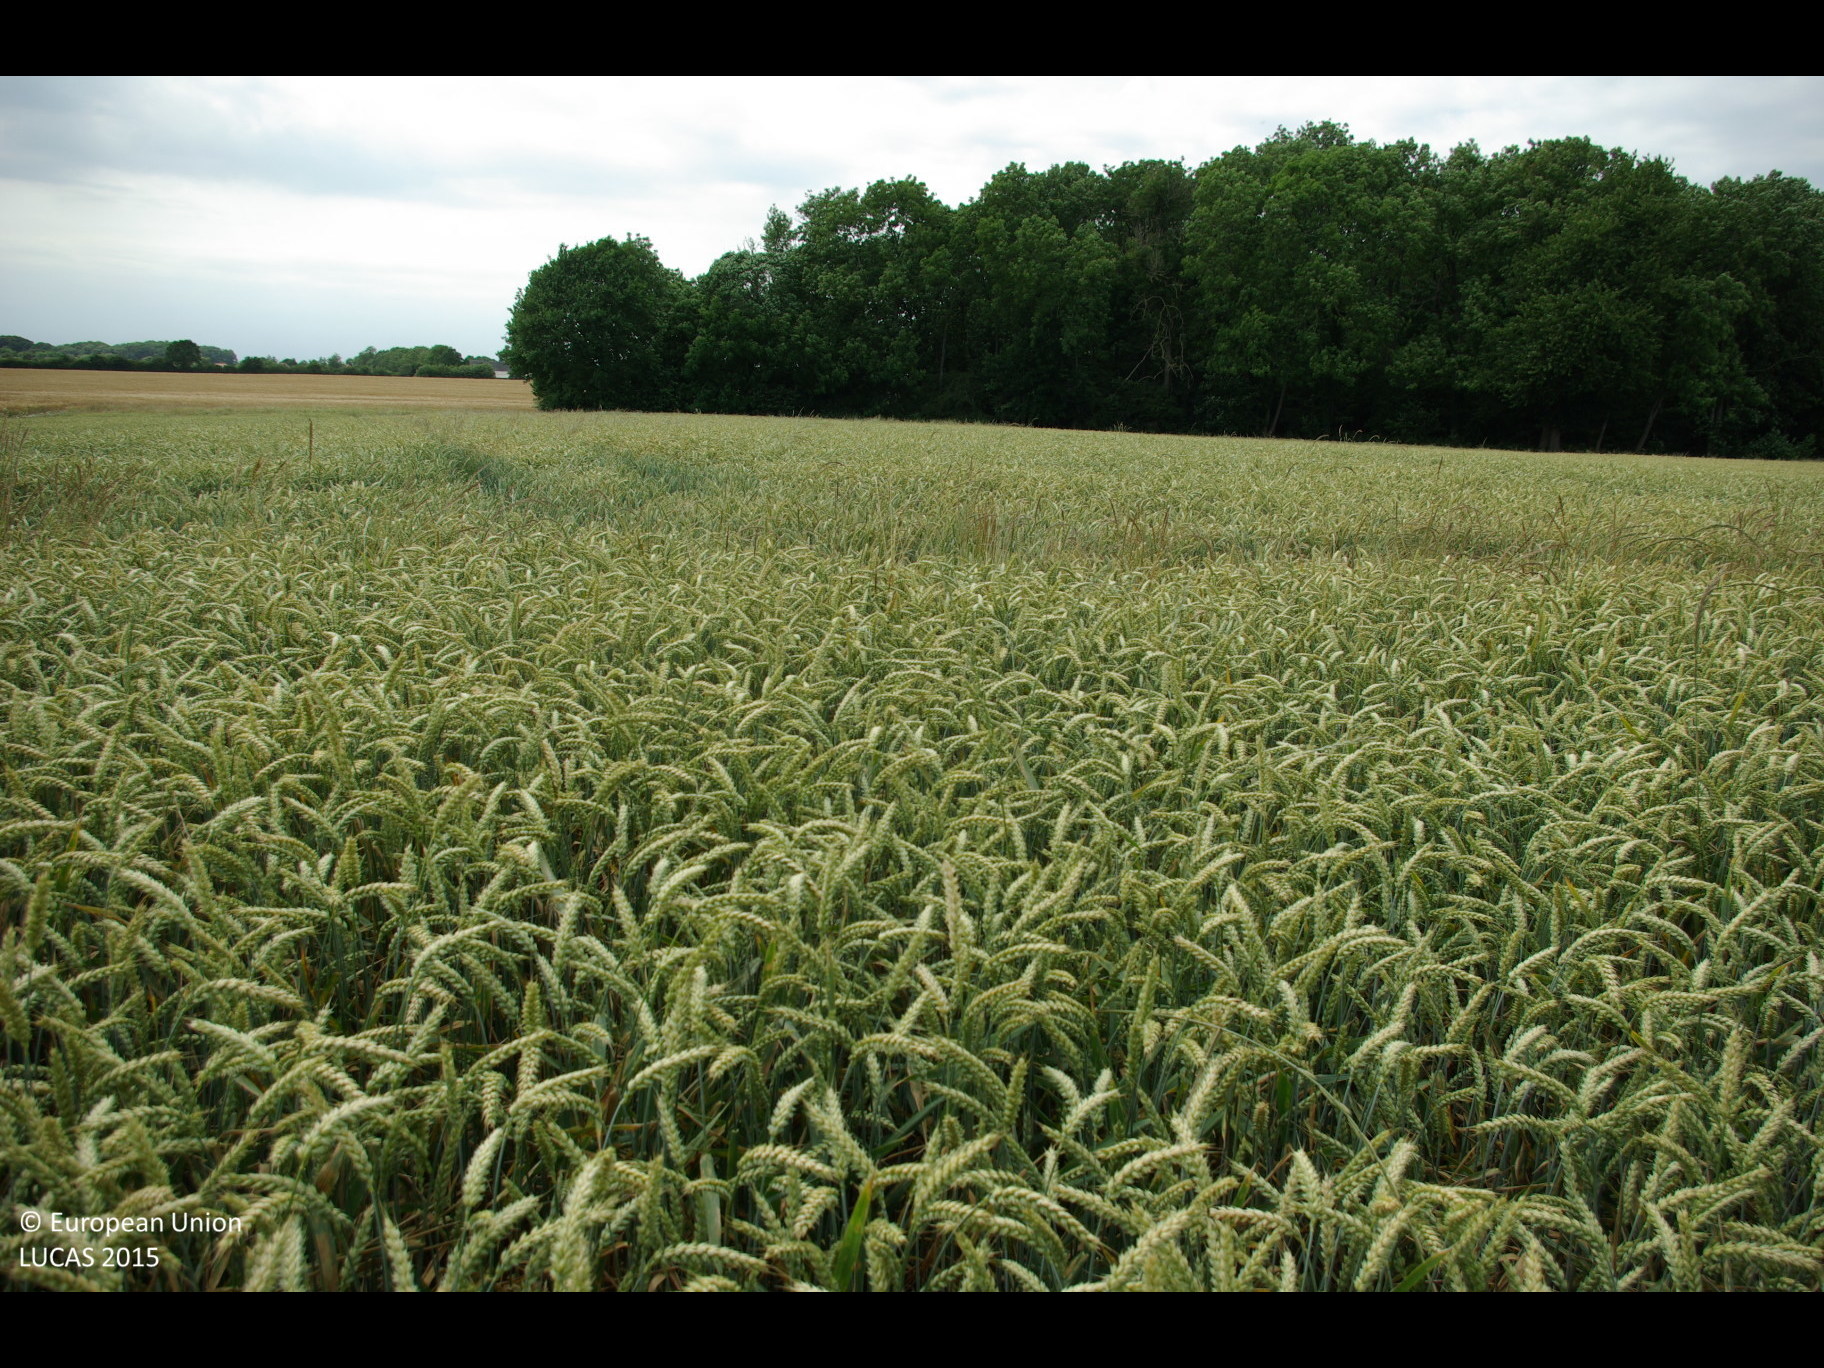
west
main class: Cropland
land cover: Common wheat
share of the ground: > 75 %
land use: Agriculture (excluding fallow land and kitchen gardens)
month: July
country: DE
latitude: 54.7139
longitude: 9.9224
